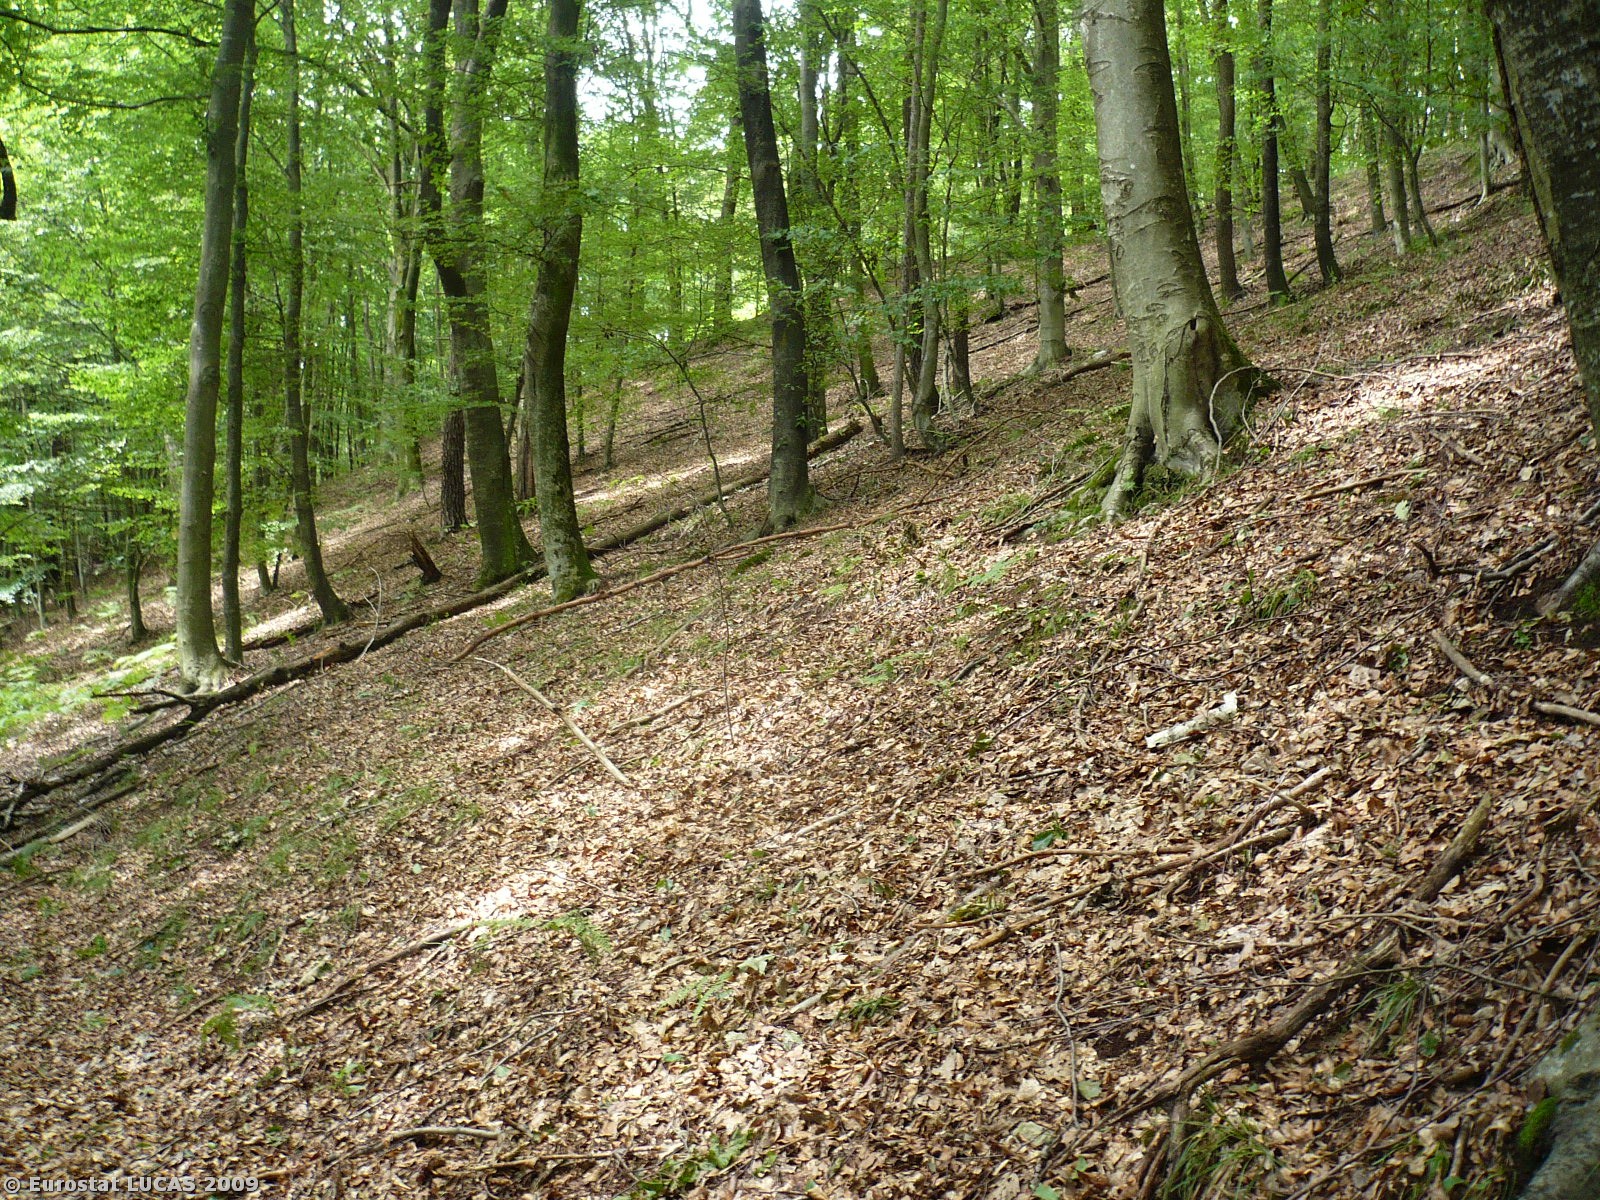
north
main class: Woodland
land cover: Broadleaved woodland
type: mesophytic deciduous forest
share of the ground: > 75 %
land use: Forestry
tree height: > 5 m
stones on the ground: < 10 %
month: June
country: SI
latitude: 46.5777
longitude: 16.0417
